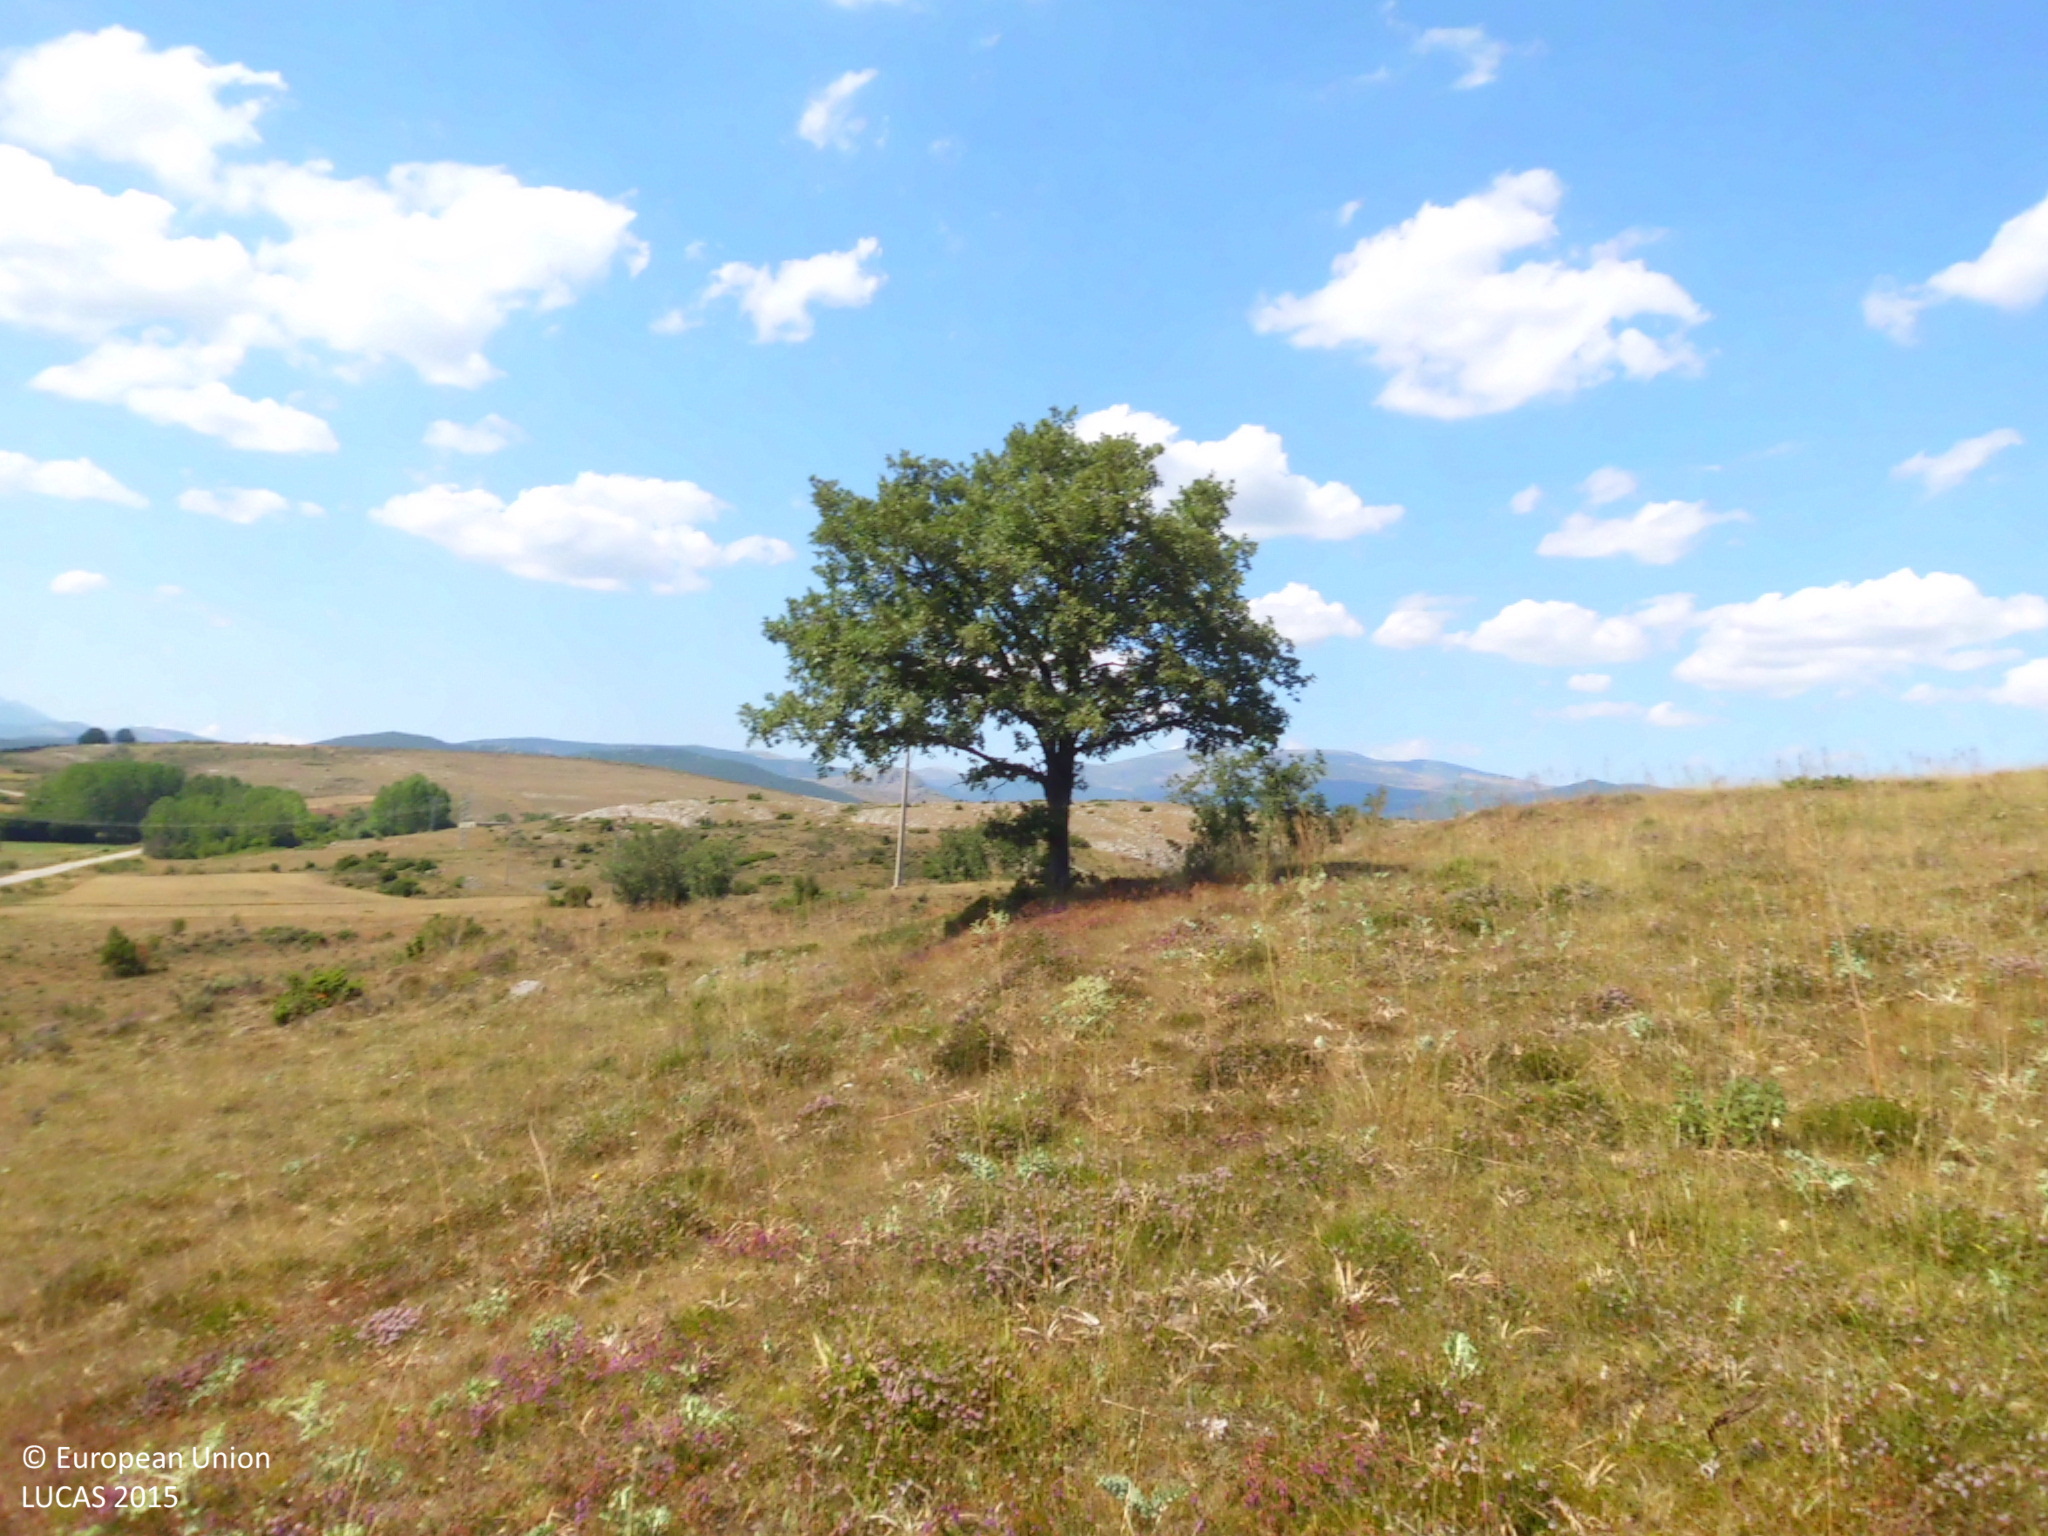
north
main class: Grassland
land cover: Grassland without tree/shrub cover
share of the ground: > 75 %
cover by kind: herbaceous plants 95 %, shrubs 5 %
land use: Agriculture (excluding fallow land and kitchen gardens)
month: July
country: ES
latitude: 42.8342
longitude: -4.3535
